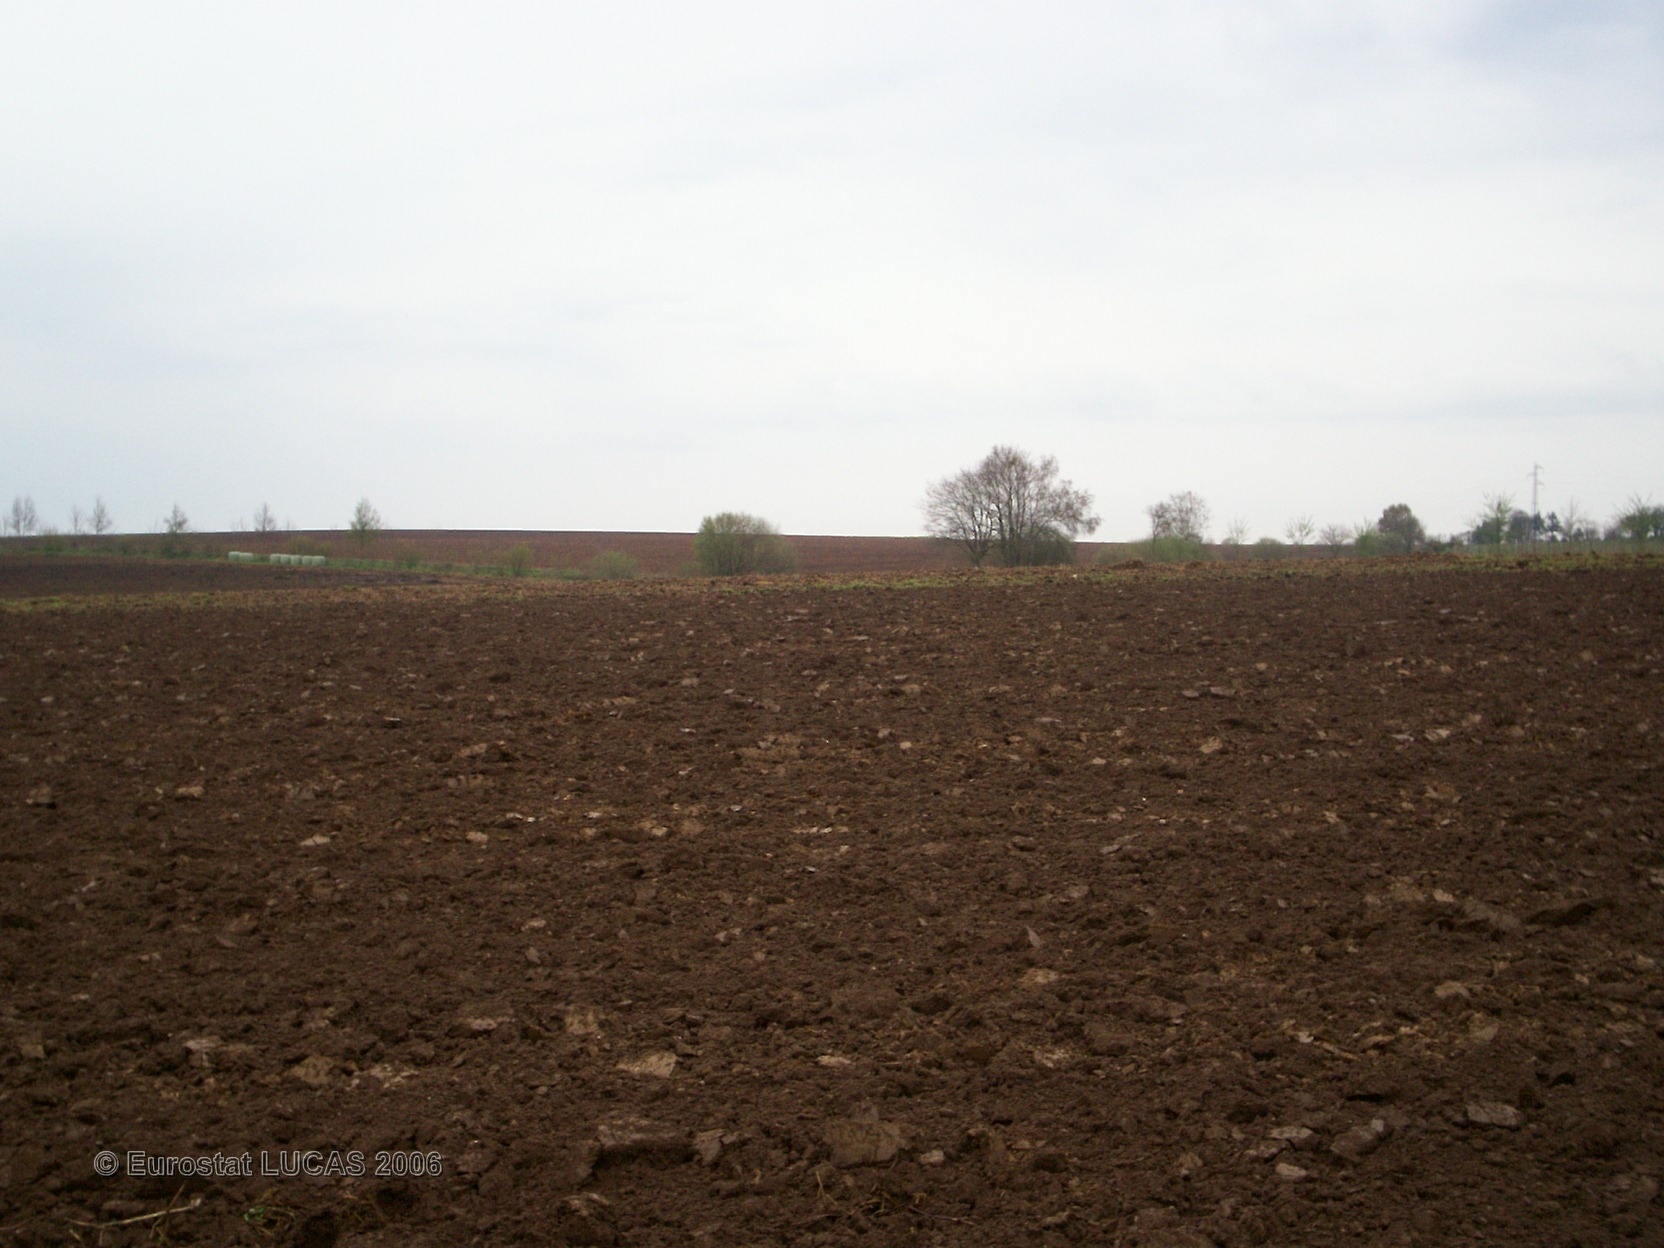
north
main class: Cropland
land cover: Maize
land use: Agriculture (excluding fallow land and kitchen gardens)
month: May
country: FR
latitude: 48.0829
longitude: -2.8862
